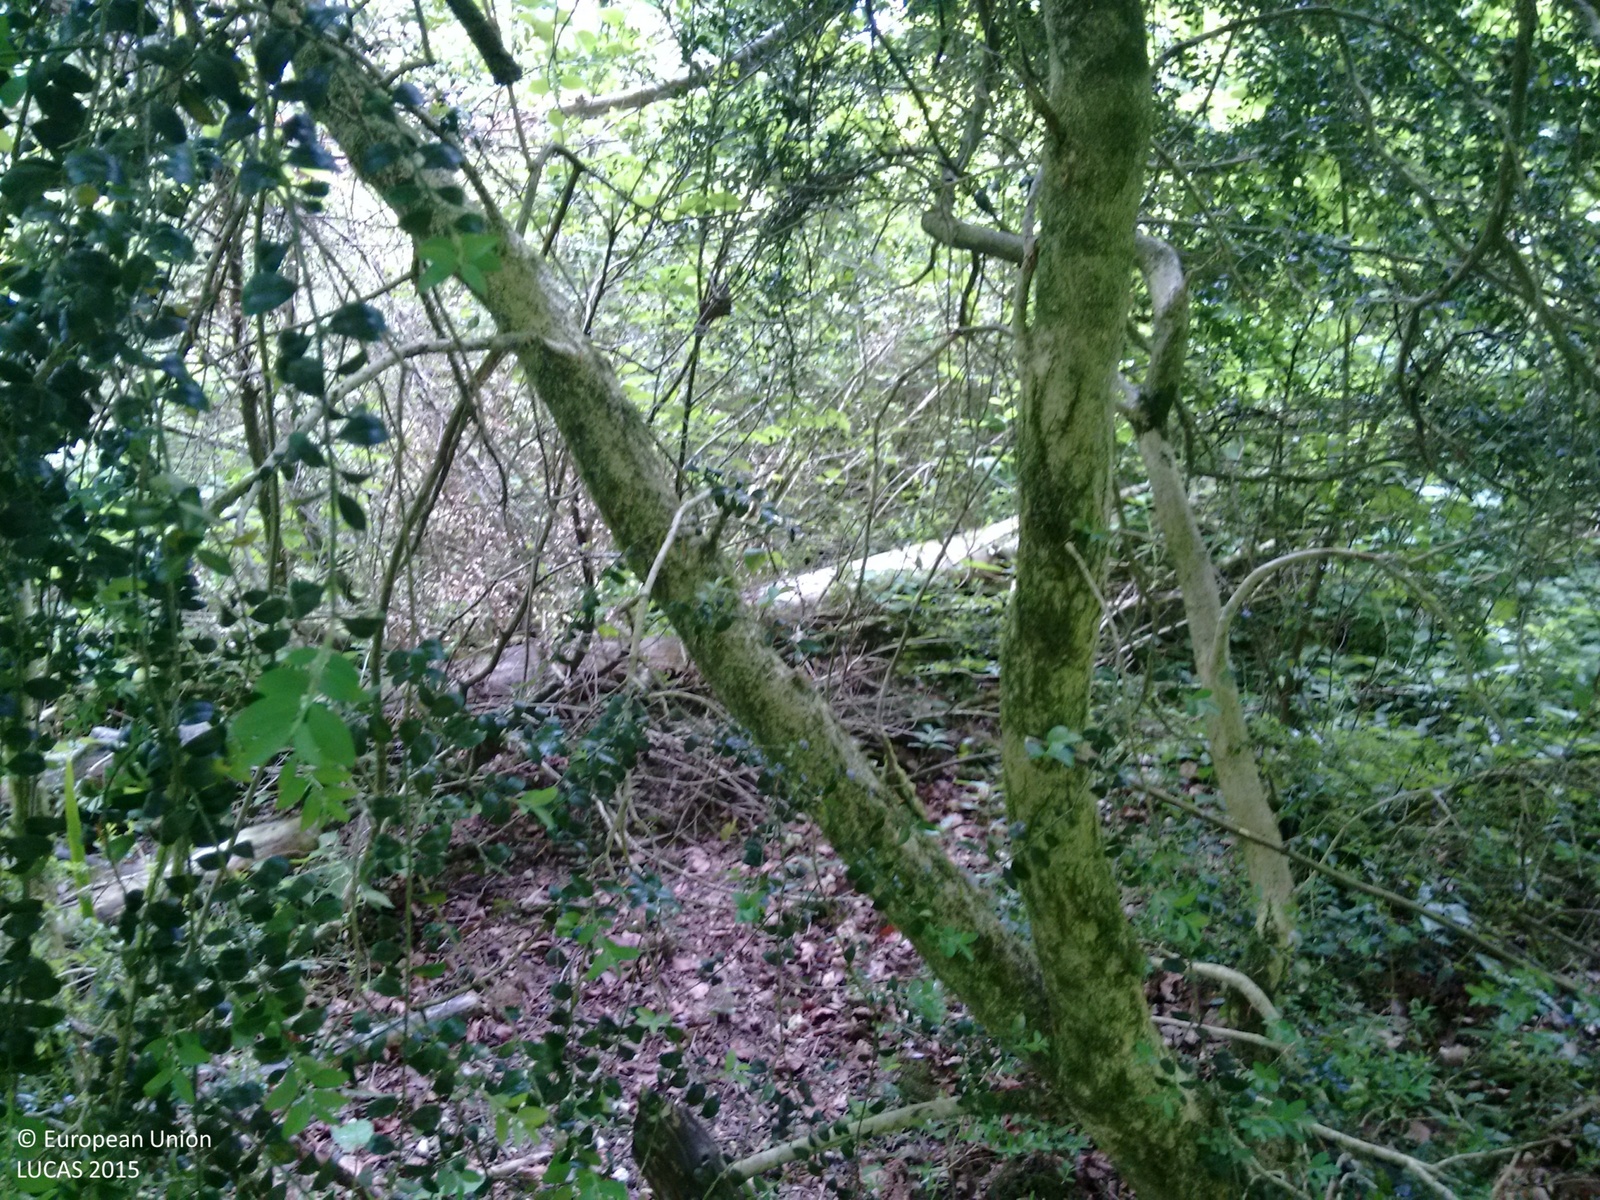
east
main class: Woodland
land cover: Broadleaved woodland
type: beech forest
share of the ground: > 75 %
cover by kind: broadleaved forest trees 95 %, herbaceous plants 5 %
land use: Semi-natural and natural areas not in use
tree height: > 5 m
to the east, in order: Broadleaved woodland; Tracks; Spruce dominated mixed woodland; Broadleaved woodland; Fences; Grassland without tree/shrub cover
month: May
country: GB
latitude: 50.8563
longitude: -2.1785
